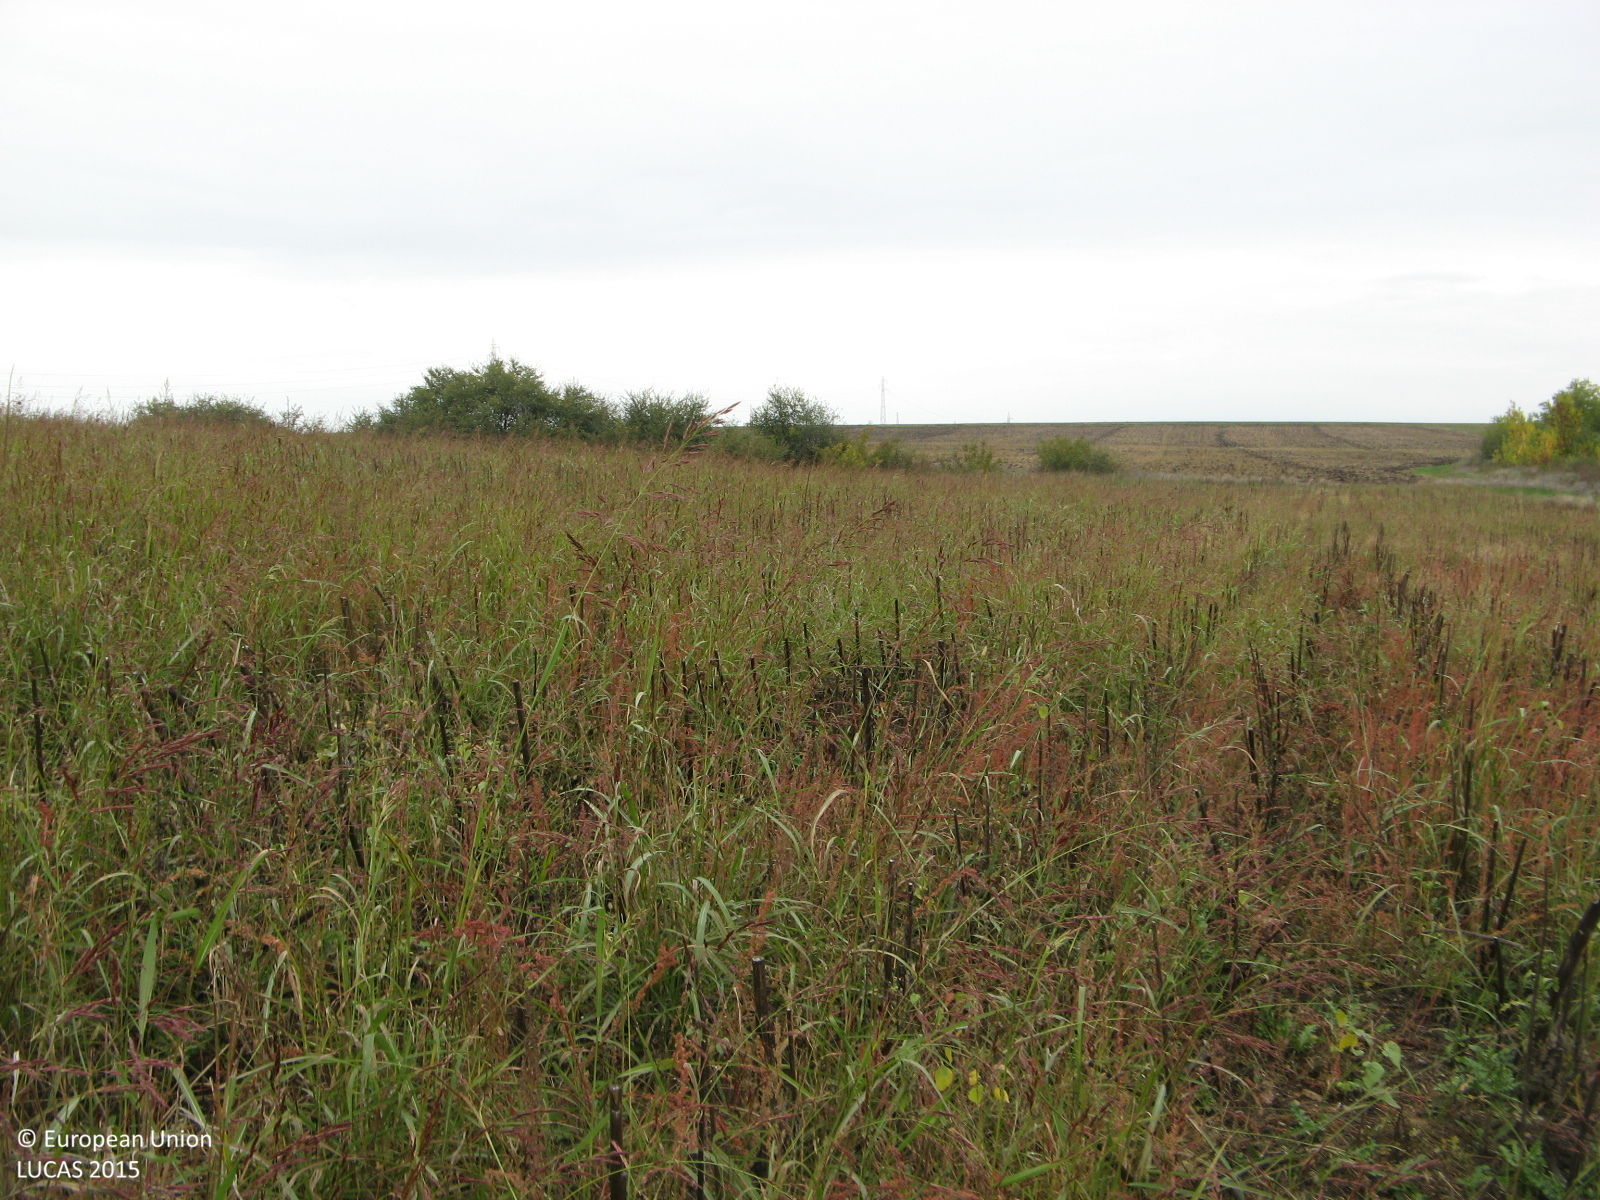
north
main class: Cropland
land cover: Sunflower
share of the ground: 10 - 25 %
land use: Agriculture (excluding fallow land and kitchen gardens)
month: October
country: BG
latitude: 42.0711
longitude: 25.1784
